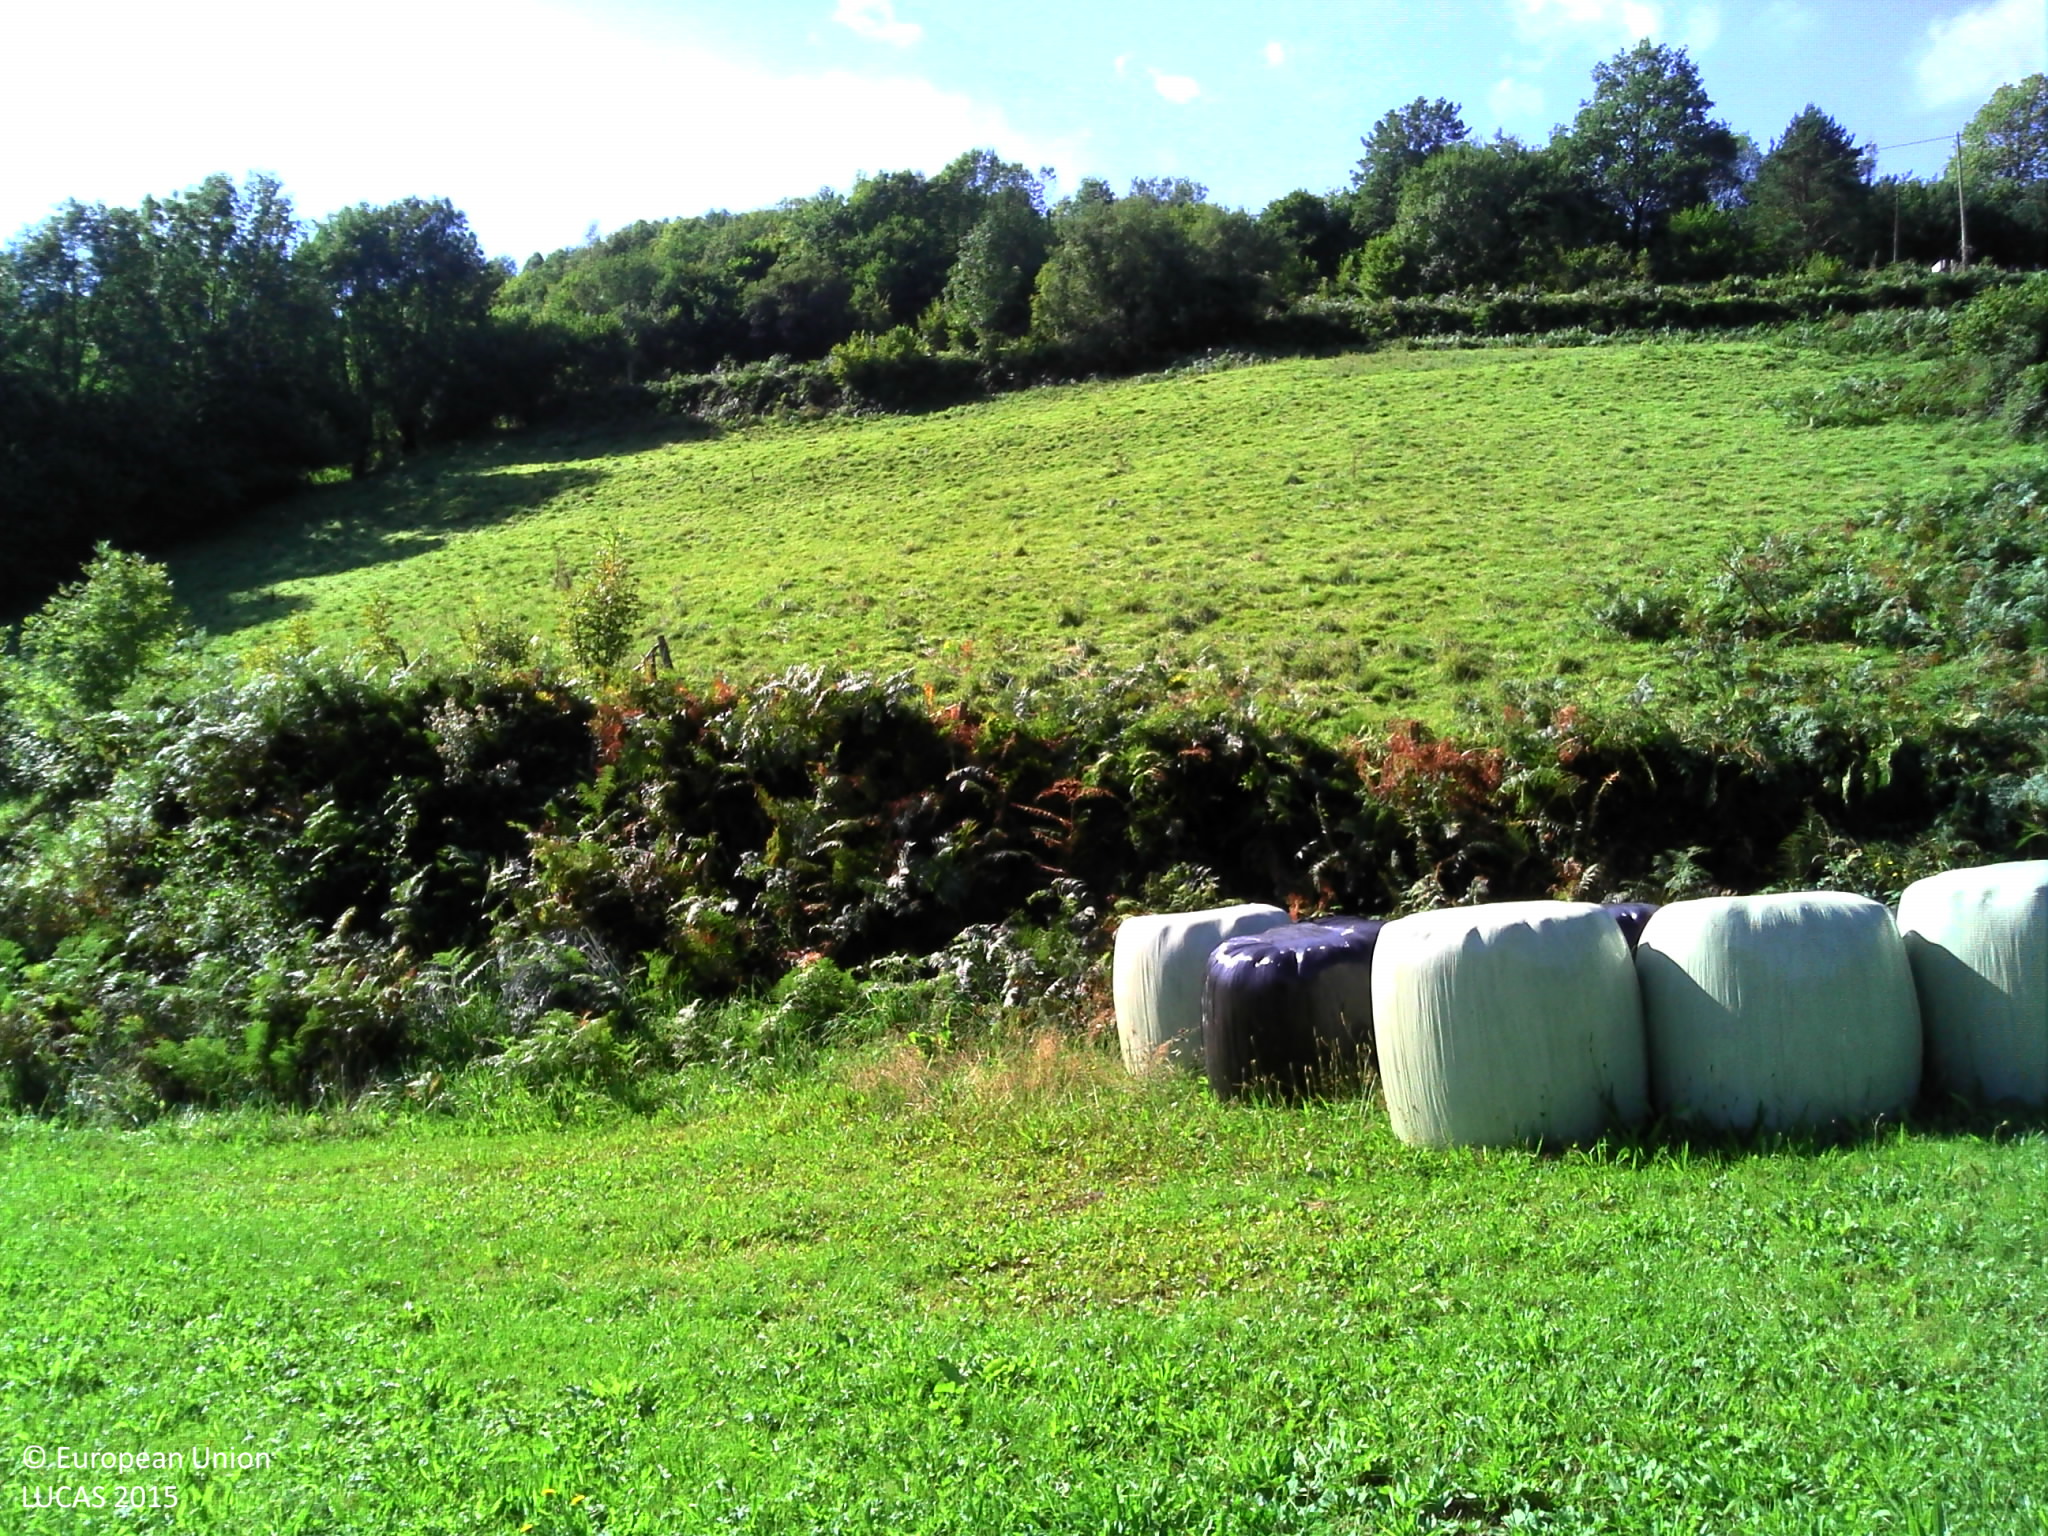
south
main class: Grassland
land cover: Grassland without tree/shrub cover
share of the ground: > 75 %
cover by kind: herbaceous plants 100 %
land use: Agriculture (excluding fallow land and kitchen gardens)
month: September
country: FR
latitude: 43.0214
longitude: -0.9678
